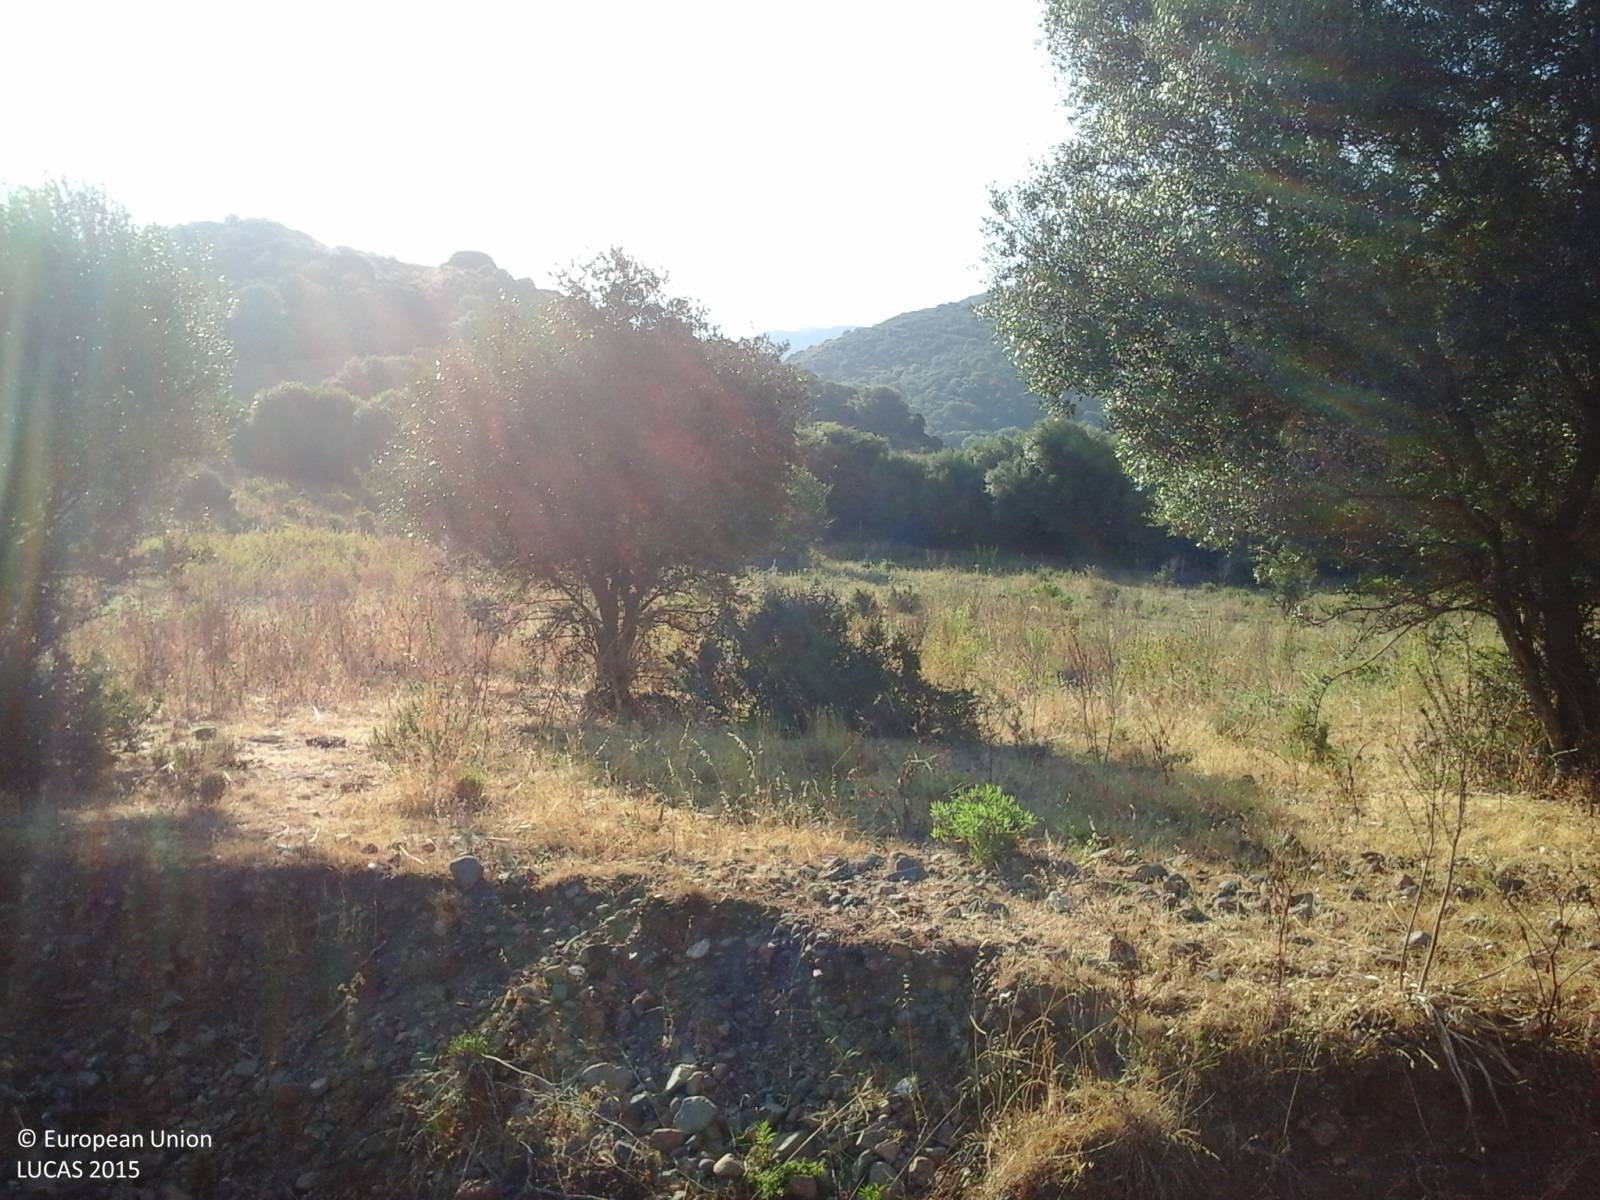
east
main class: Grassland
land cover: Grassland with sparse tree/shrub cover
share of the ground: 50 - 75 %
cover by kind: herbaceous plants 75 %, shrubs 10 %, unconsolidated bare surface 10 %, broadleaved forest trees 5 %
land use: Agriculture (excluding fallow land and kitchen gardens)
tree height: < 5 m
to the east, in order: Grassland with sparse tree/shrub cover; Ditches and canals; Grassland with sparse tree/shrub cover; Grassland without tree/shrub cover; Abandoned hedges; Dry stone walls; Fences; Tracks; Grassland with sparse tree/shrub cover; Dry stone walls; Grassland with sparse tree/shrub cover; Fences; Shrubland with sparse tree cover
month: June
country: IT
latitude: 40.9127
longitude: 8.9010
